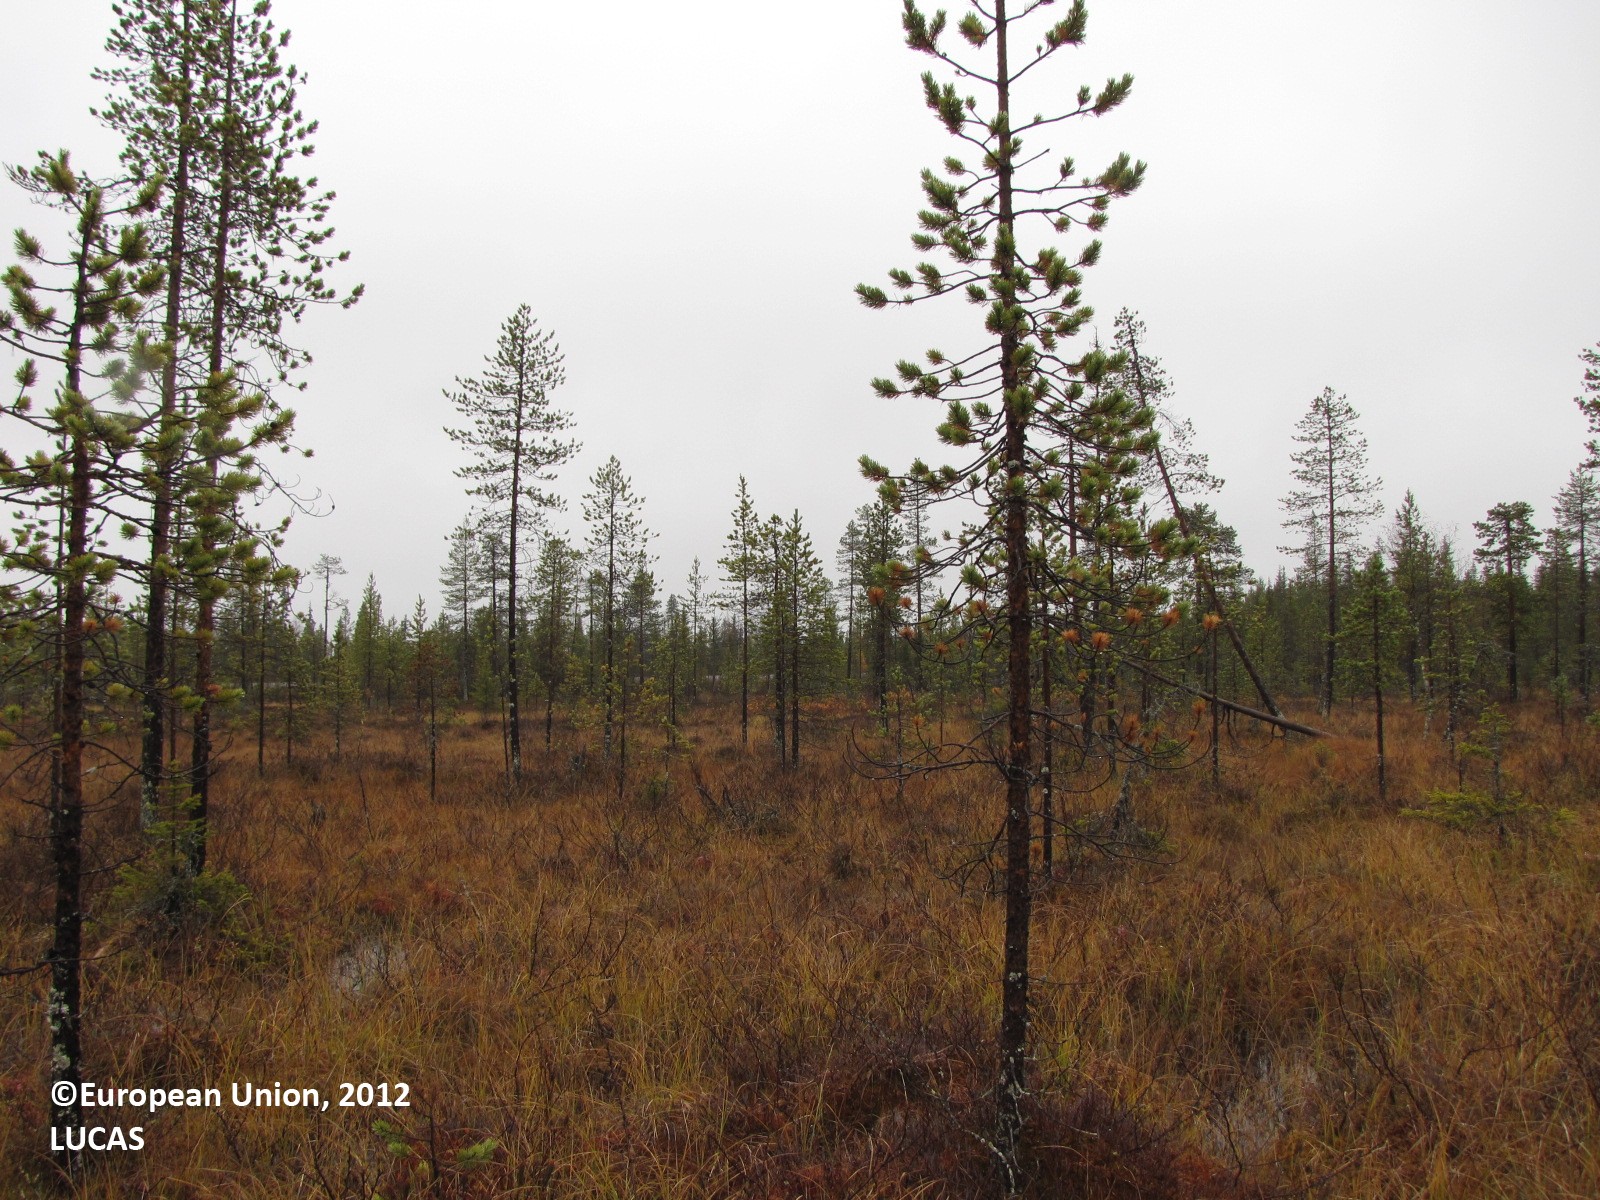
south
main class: Woodland
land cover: Pine dominated coniferous woodland
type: boreal forest
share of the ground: 10 - 25 %
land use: Forestry
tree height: < 5 m
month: September
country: FI
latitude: 67.7147
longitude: 23.6017
